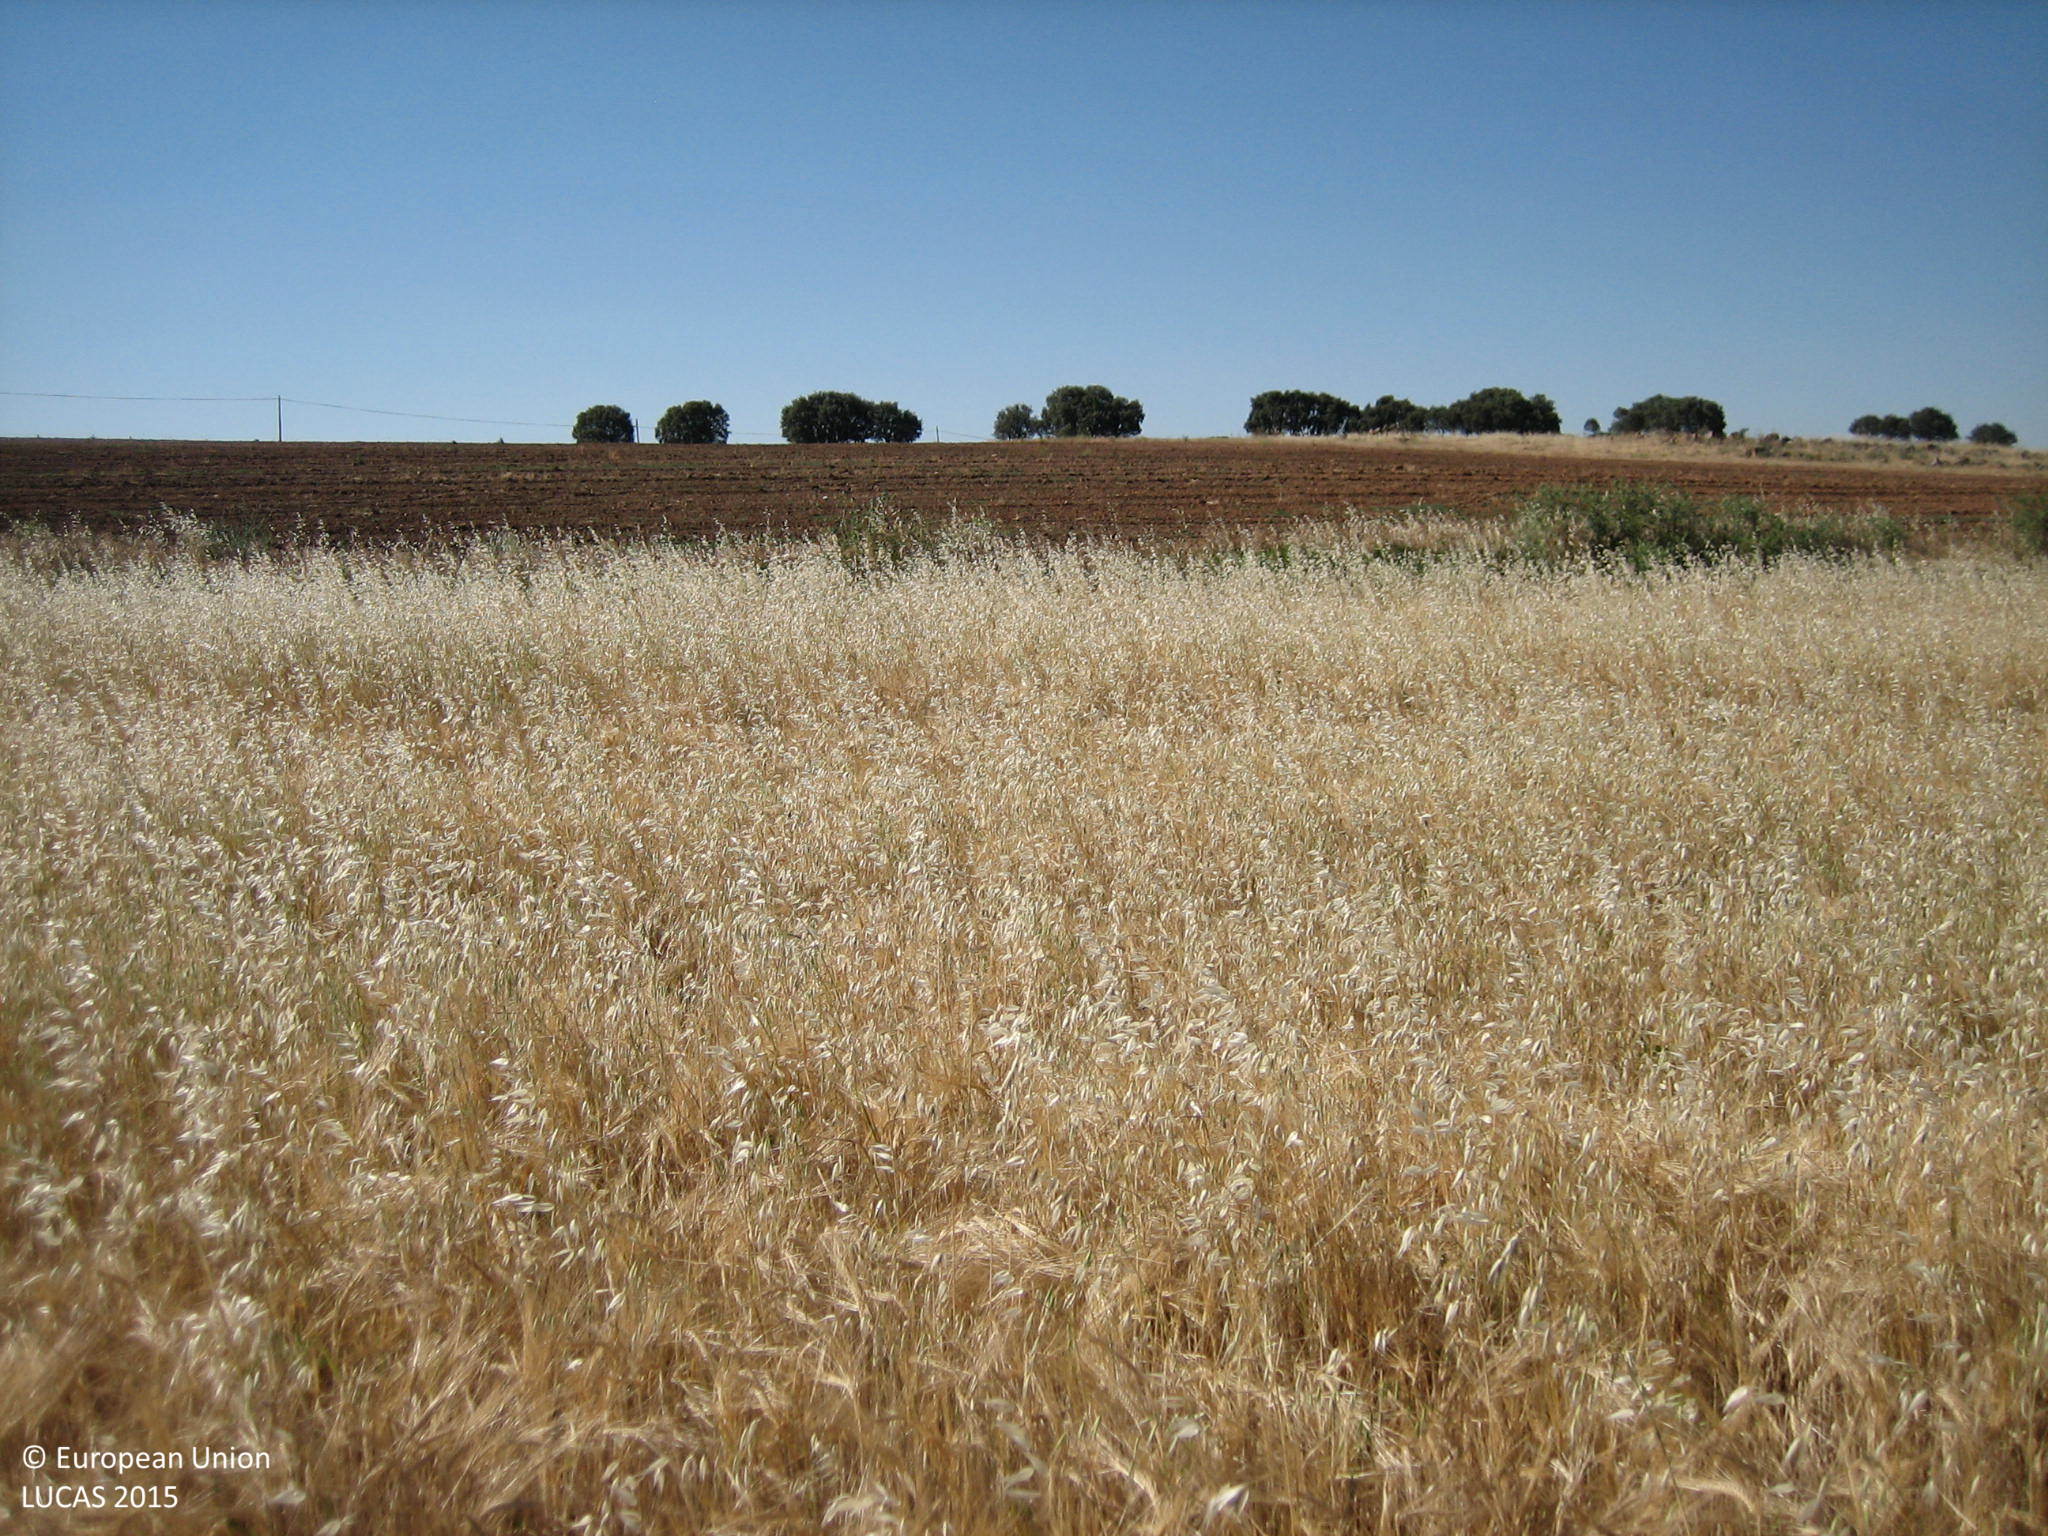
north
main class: Cropland
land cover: Barley
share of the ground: > 75 %
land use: Agriculture (excluding fallow land and kitchen gardens)
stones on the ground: < 10 %
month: June
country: ES
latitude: 38.8661
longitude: -4.0461
